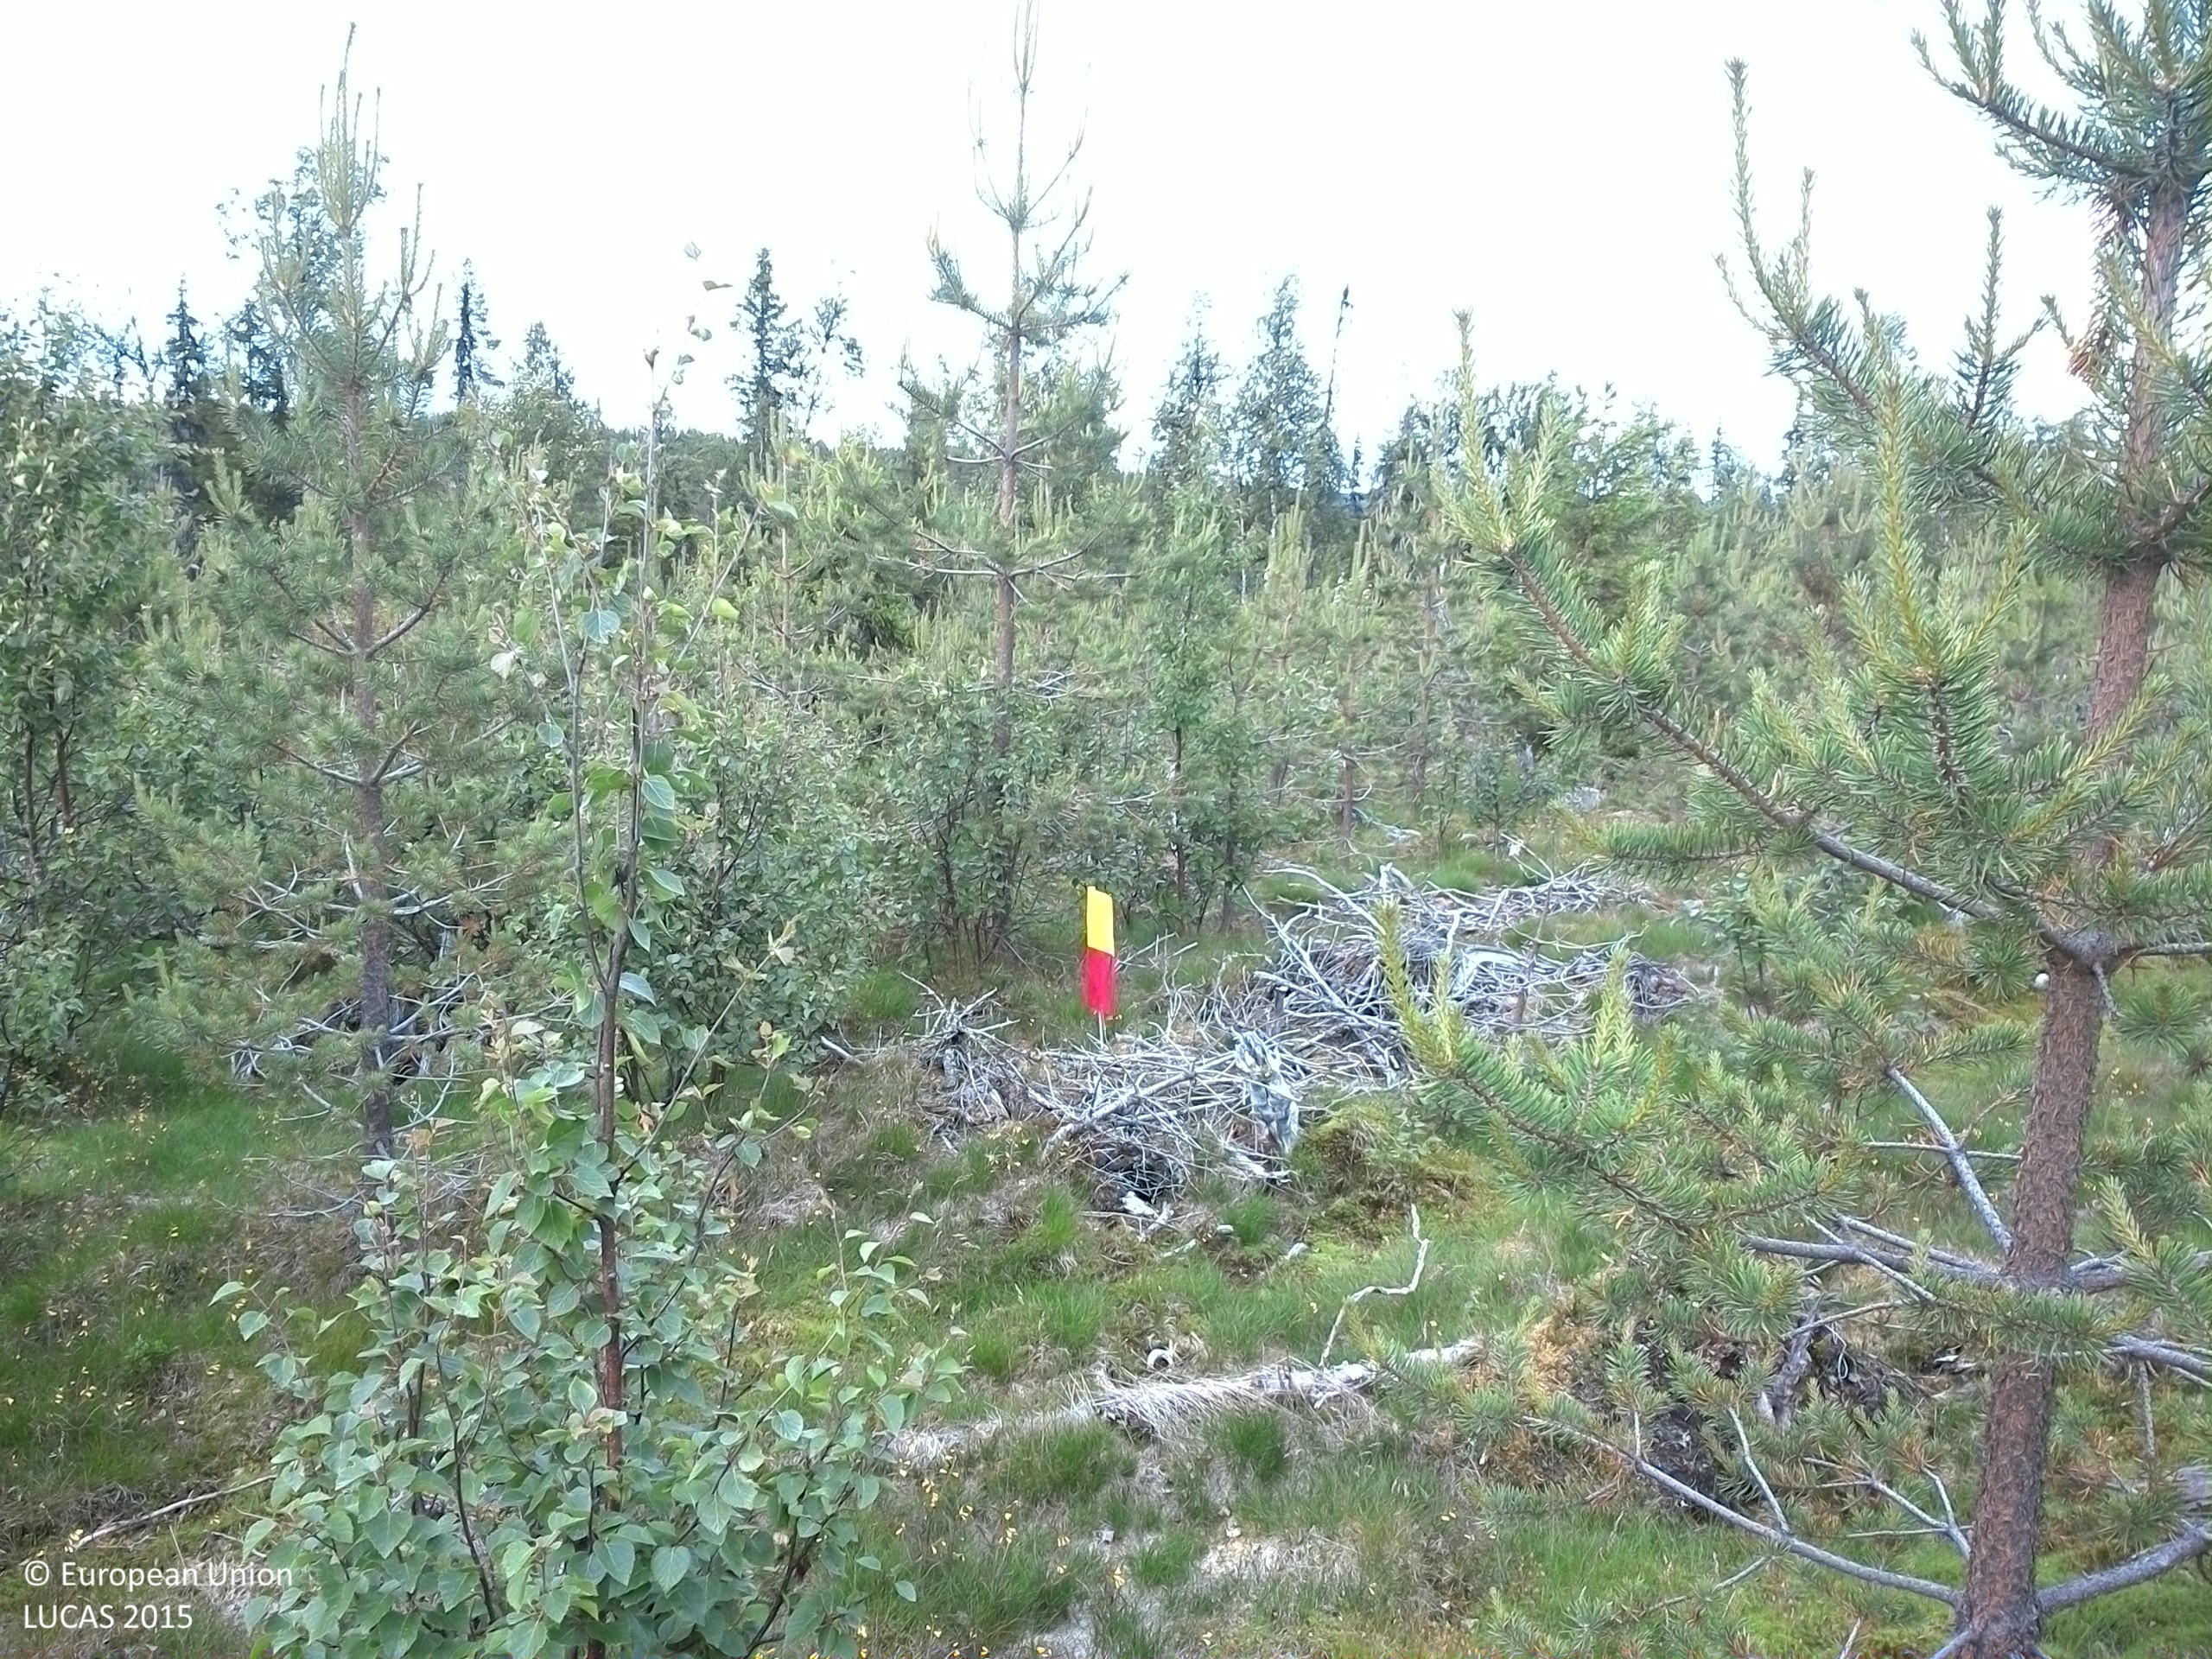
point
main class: Woodland
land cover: Pine dominated coniferous woodland
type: boreal forest
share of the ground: 10 - 25 %
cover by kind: herbaceous plants 60 %, coniferous forest trees 20 %, lichens and mosses 15 %, broadleaved forest trees 5 %
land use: Forestry
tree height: < 5 m
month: July
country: SE
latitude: 64.6765
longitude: 15.6890
